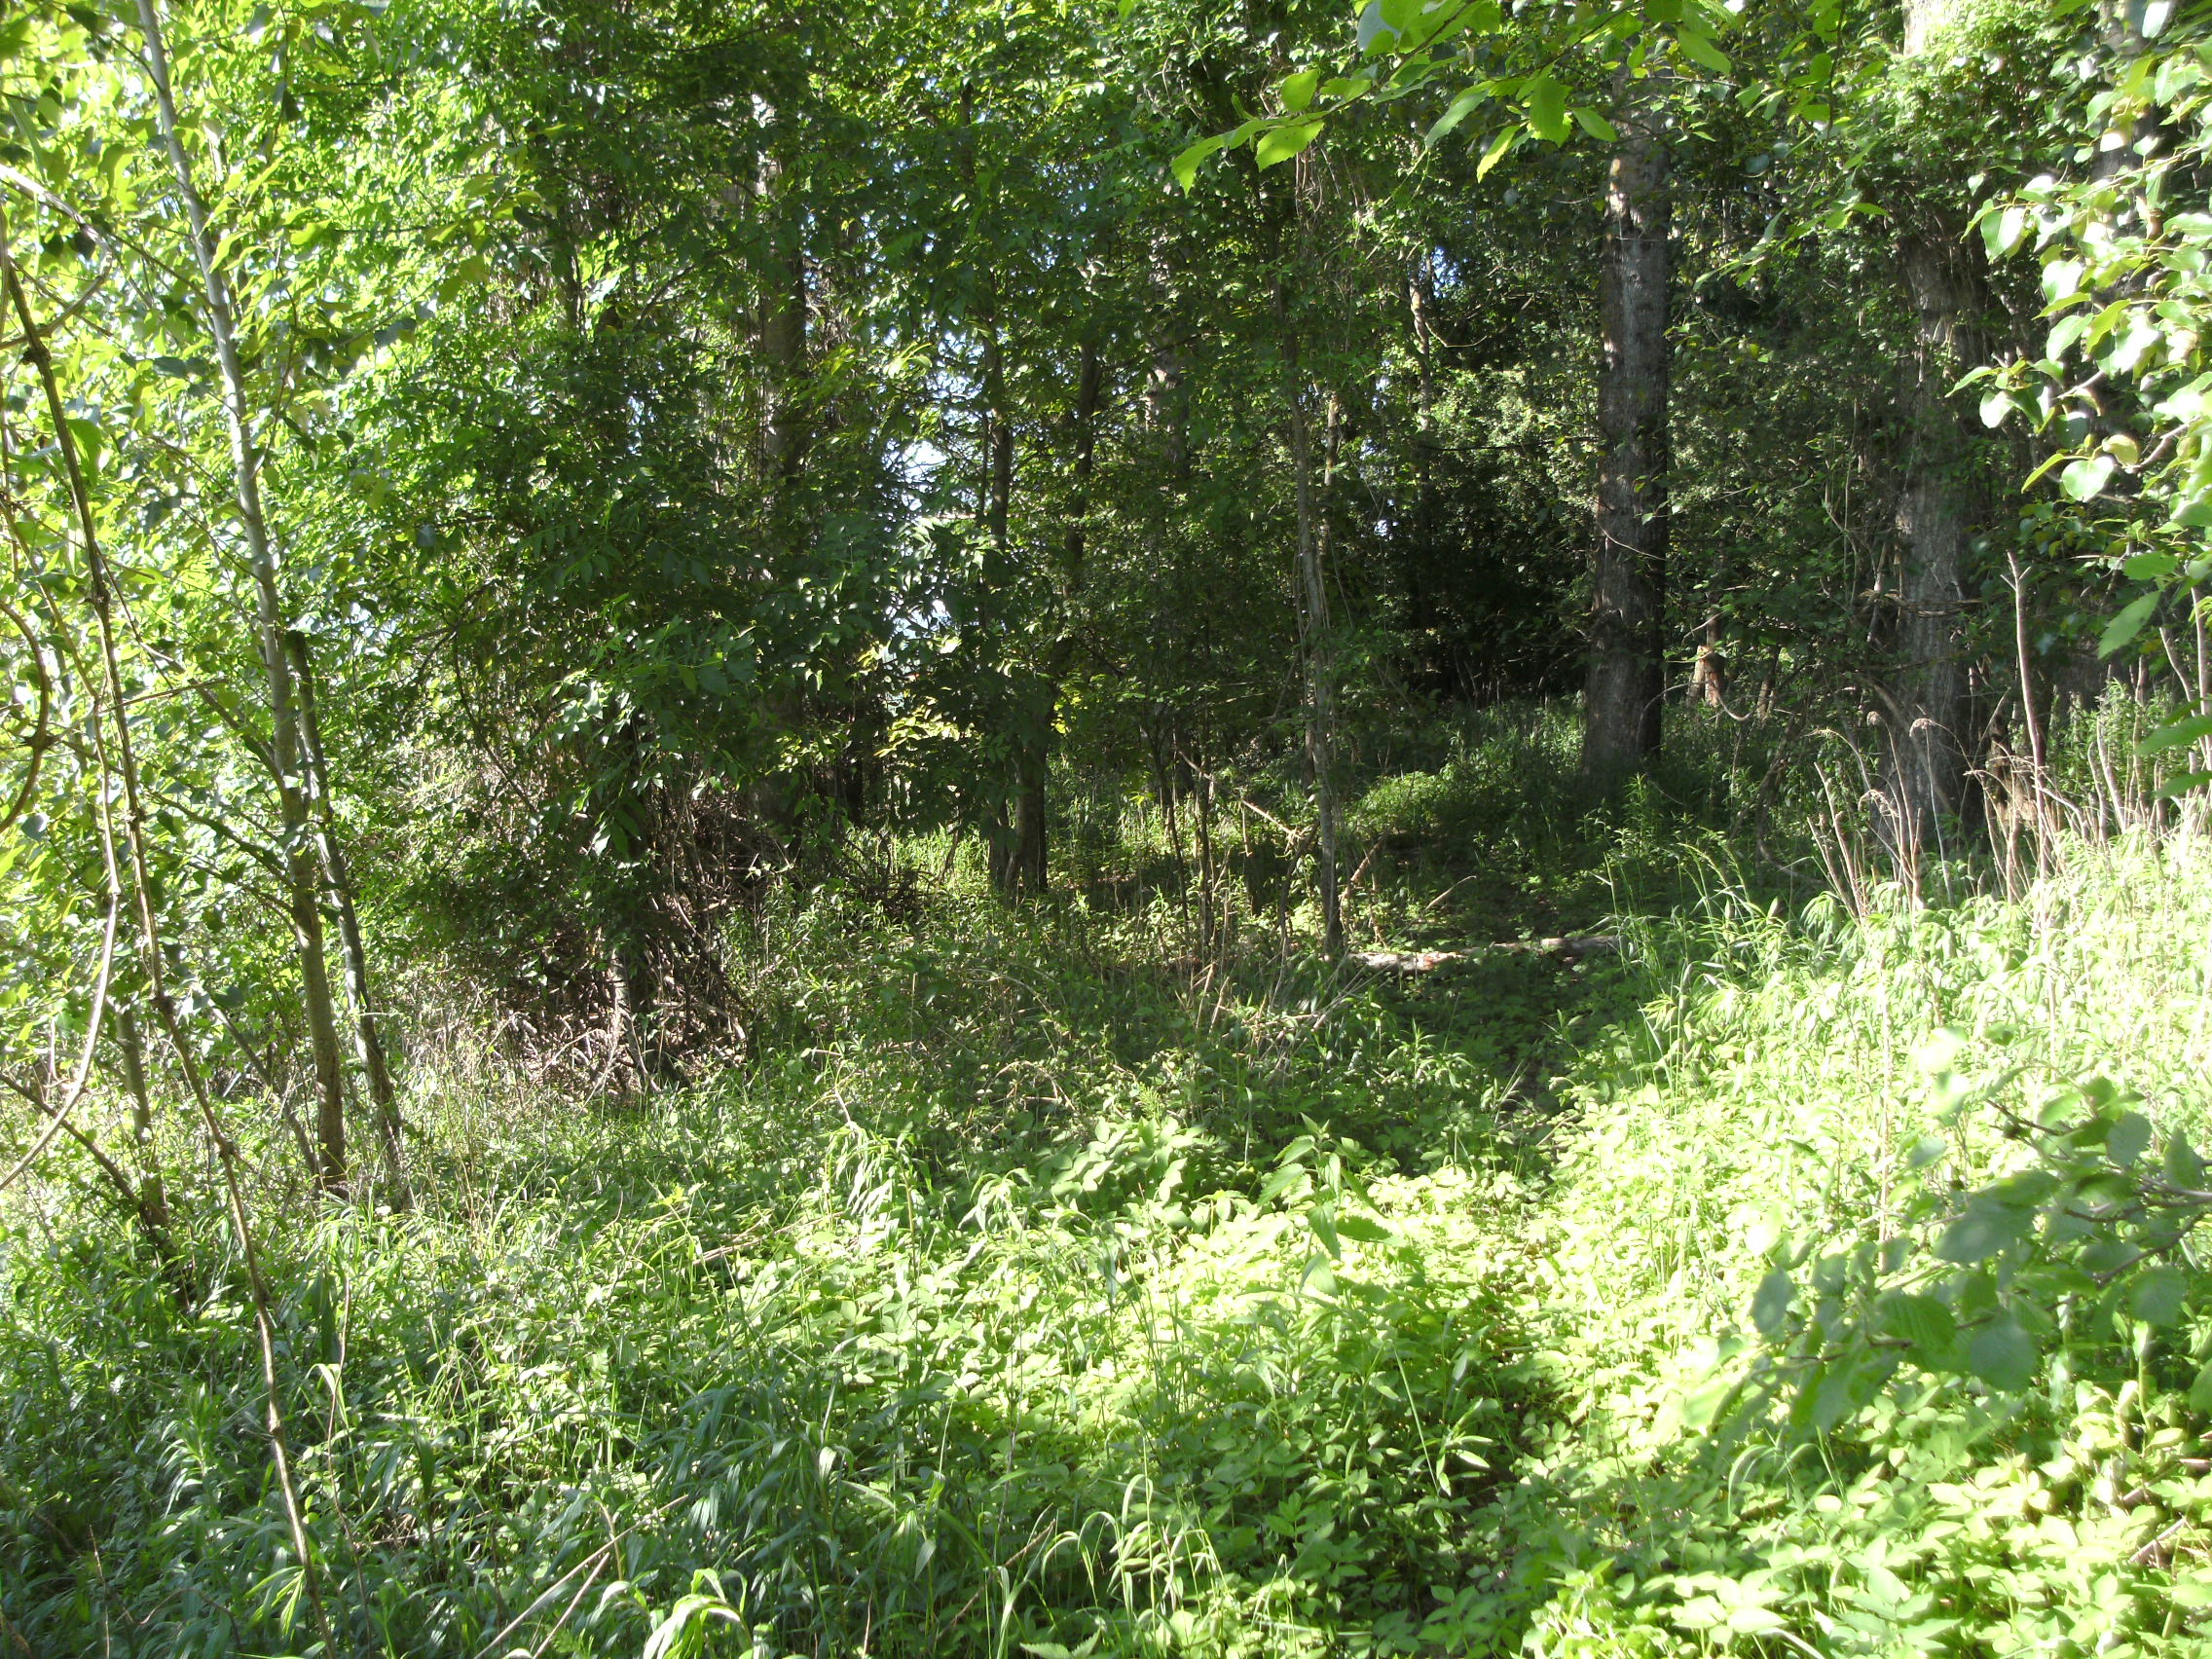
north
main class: Woodland
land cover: Broadleaved woodland
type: mesophytic deciduous forest
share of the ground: > 75 %
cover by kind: broadleaved forest trees 80 %, herbaceous plants 20 %
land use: Semi-natural and natural areas not in use
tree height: > 5 m
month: May
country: AT
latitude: 48.3070
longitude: 14.1661
